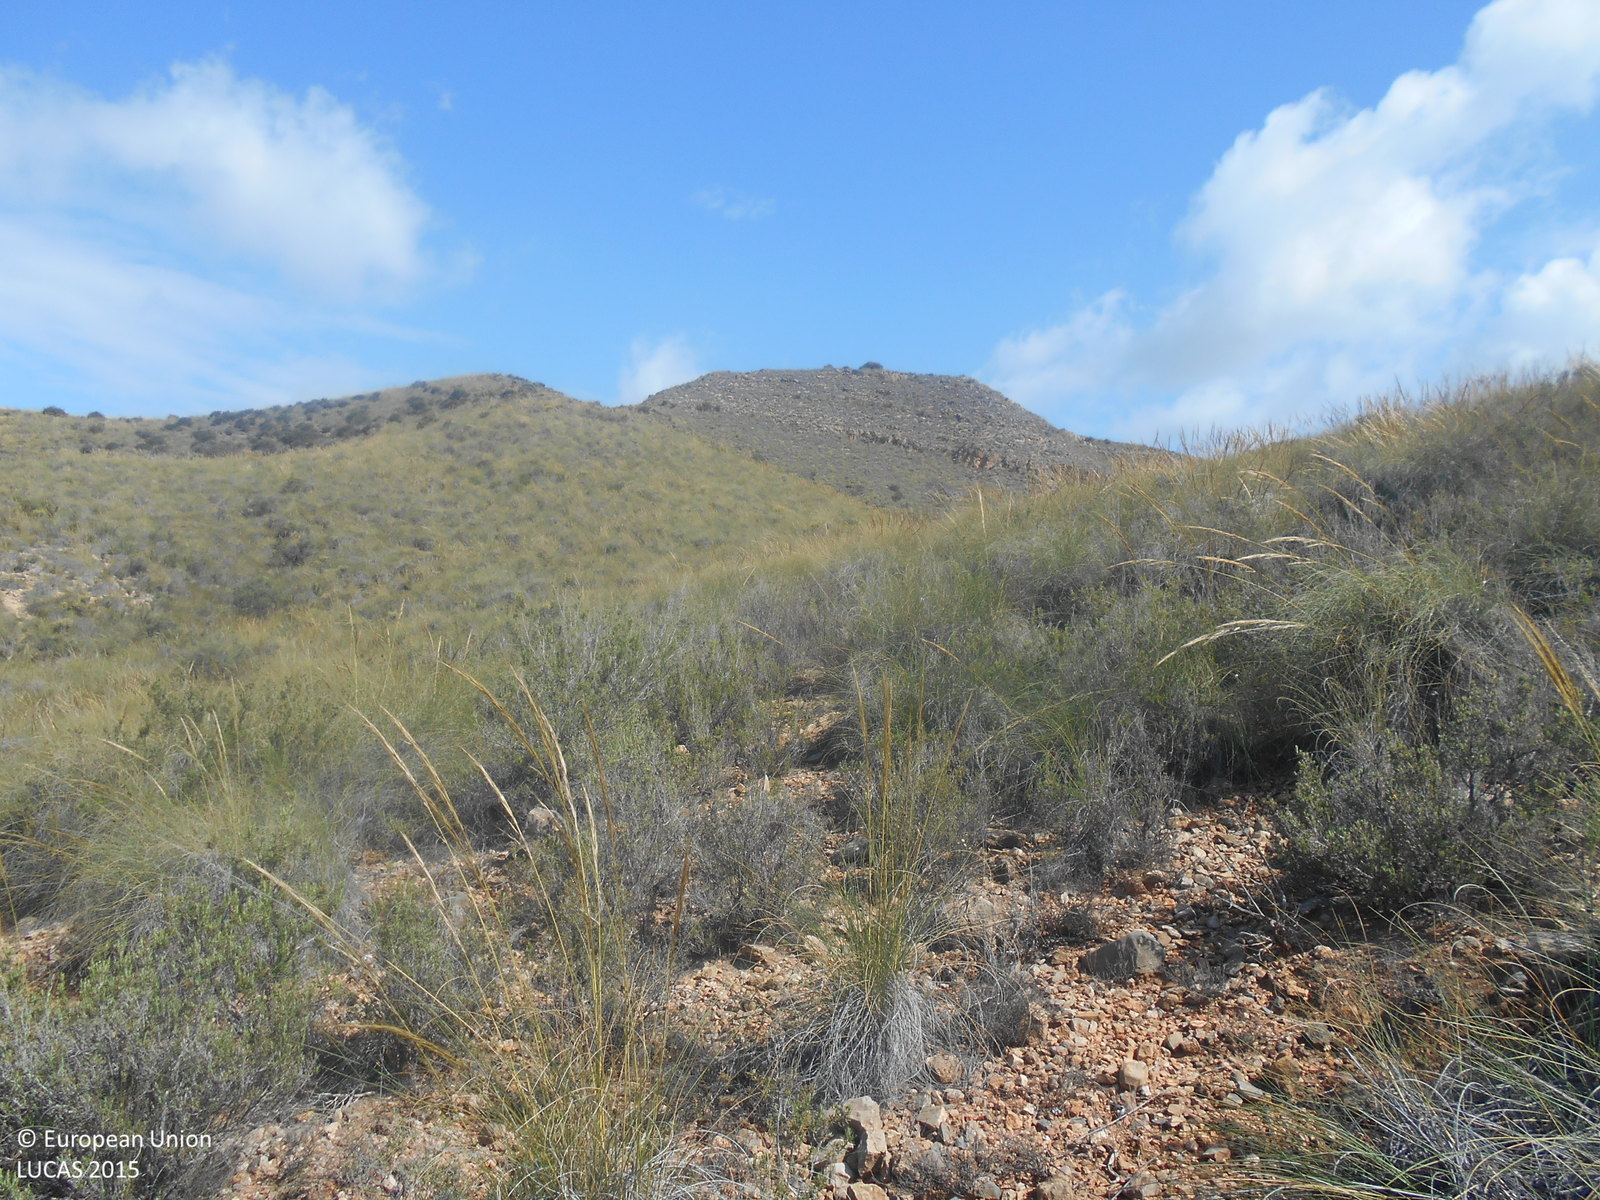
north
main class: Shrubland
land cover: Shrubland without tree cover
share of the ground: > 75 %
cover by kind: shrubs 80 %, unconsolidated bare surface 15 %, consolidated bare surface 5 %
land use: Semi-natural and natural areas not in use
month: April
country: ES
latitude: 37.8001
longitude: -1.3282
